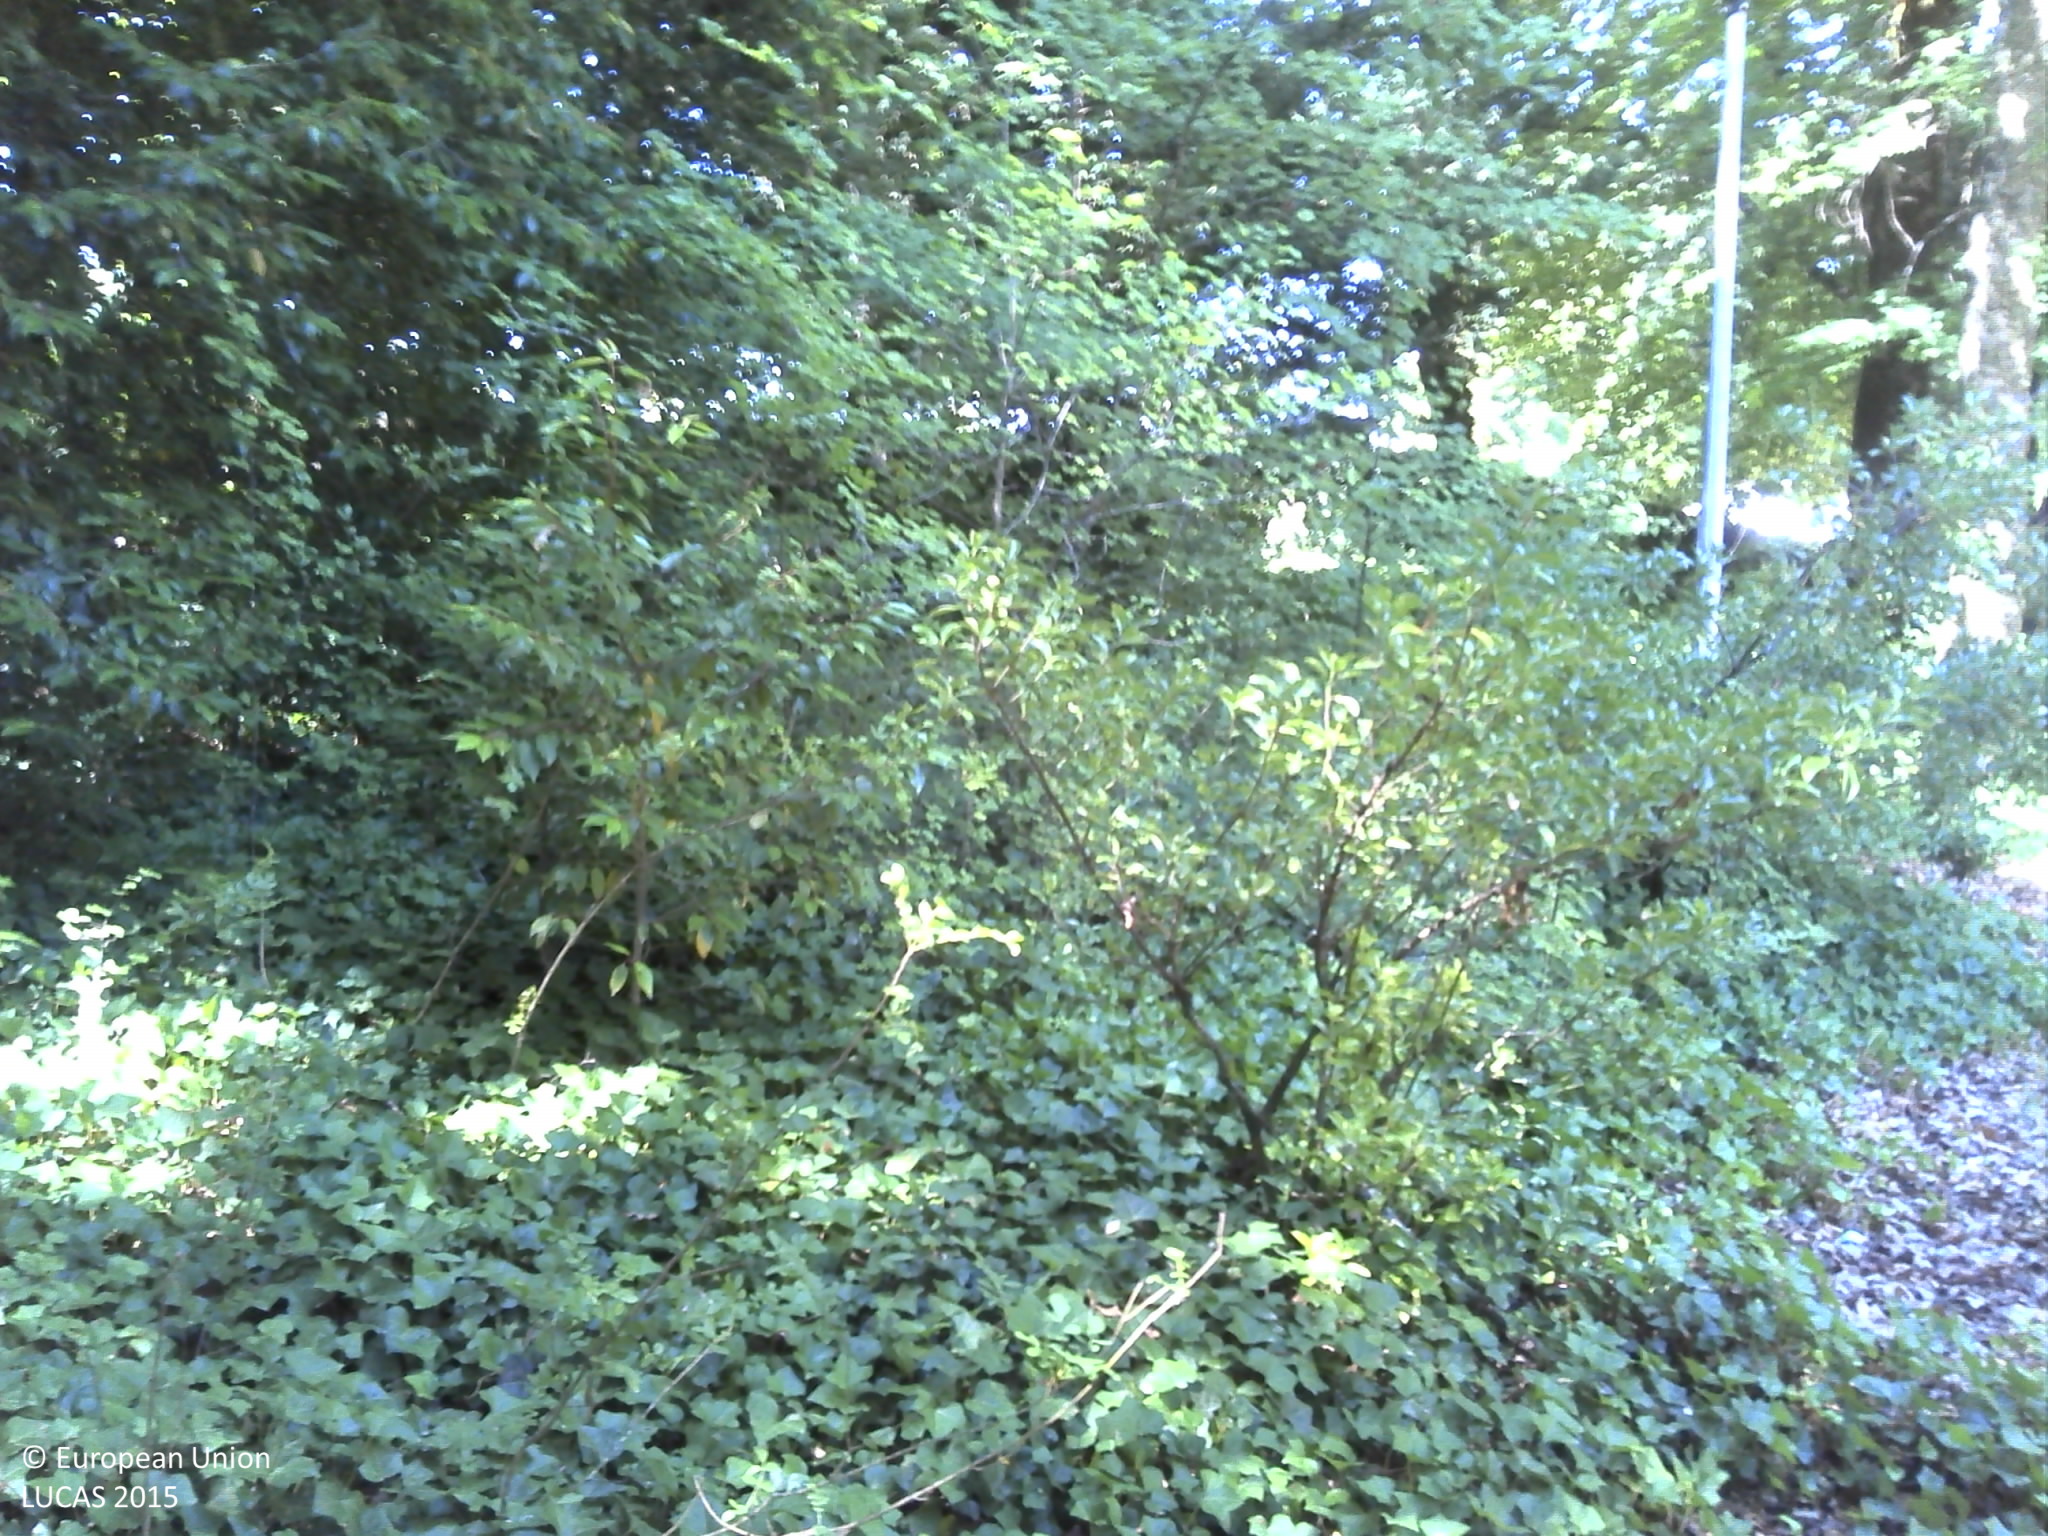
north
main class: Woodland
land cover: Broadleaved woodland
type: thermophilous deciduous forest
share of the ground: 50 - 75 %
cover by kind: broadleaved forest trees 50 %, herbaceous plants 25 %, unconsolidated bare surface 20 %, coniferous forest trees 5 %
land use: Amenities, museums, leisure
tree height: > 5 m
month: June
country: PT
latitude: 40.7742
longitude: -7.3509
